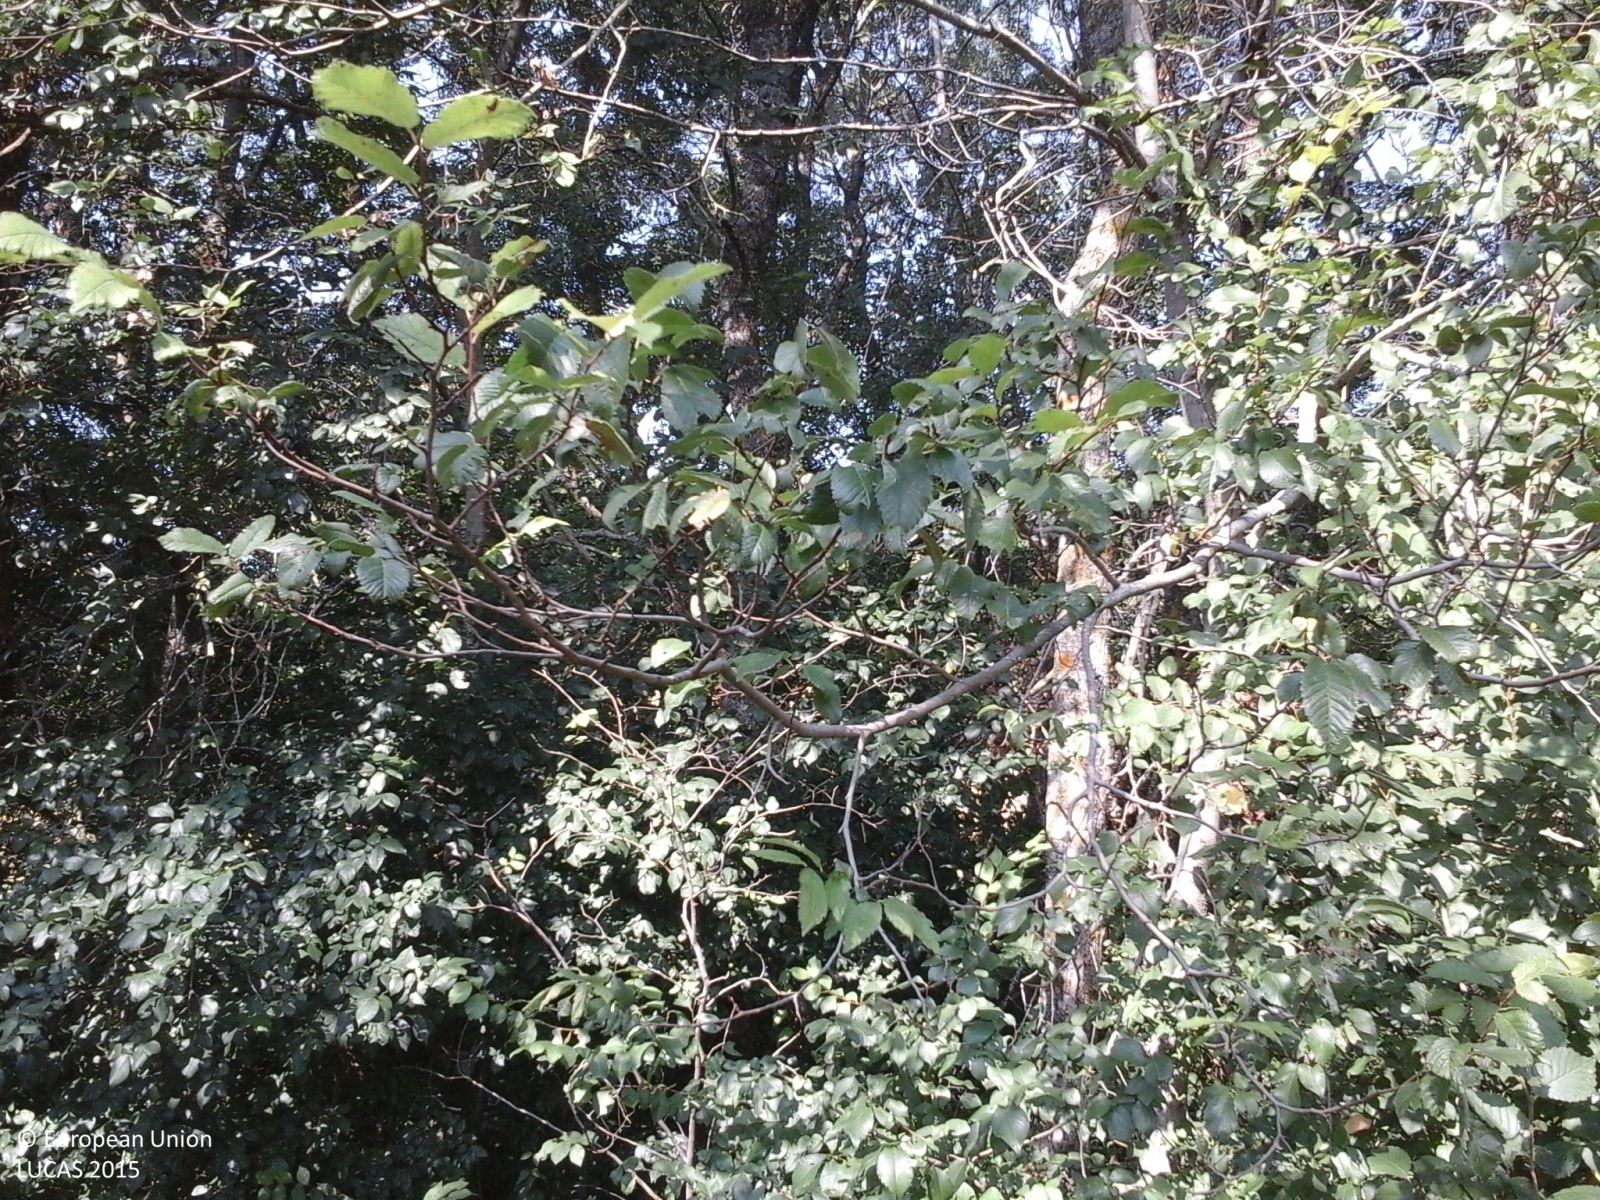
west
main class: Woodland
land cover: Broadleaved woodland
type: thermophilous deciduous forest
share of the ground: > 75 %
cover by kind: broadleaved forest trees 90 %, shrubs 5 %, herbaceous plants 5 %
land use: Forestry
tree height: > 5 m
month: August
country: IT
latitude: 41.4386
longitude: 15.1168
